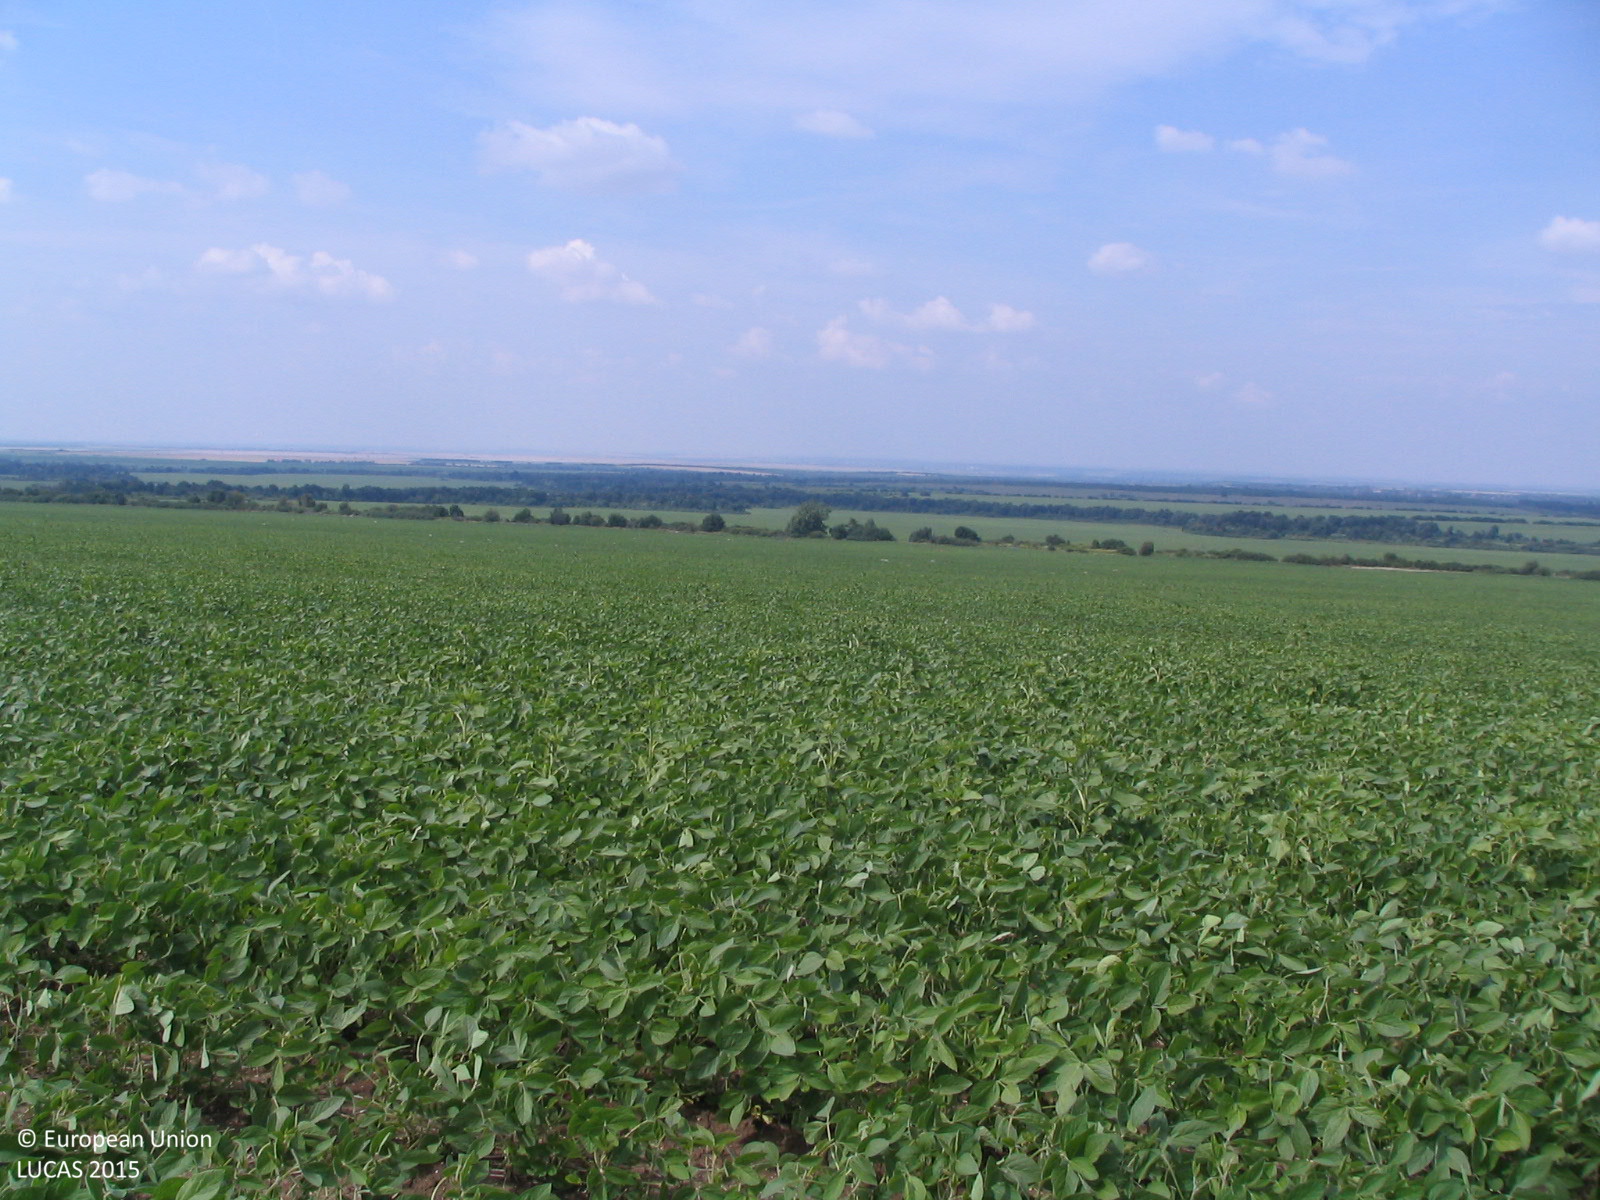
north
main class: Cropland
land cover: Dry pulses
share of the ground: > 75 %
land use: Agriculture (excluding fallow land and kitchen gardens)
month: June
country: BG
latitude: 43.3188
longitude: 23.8966
